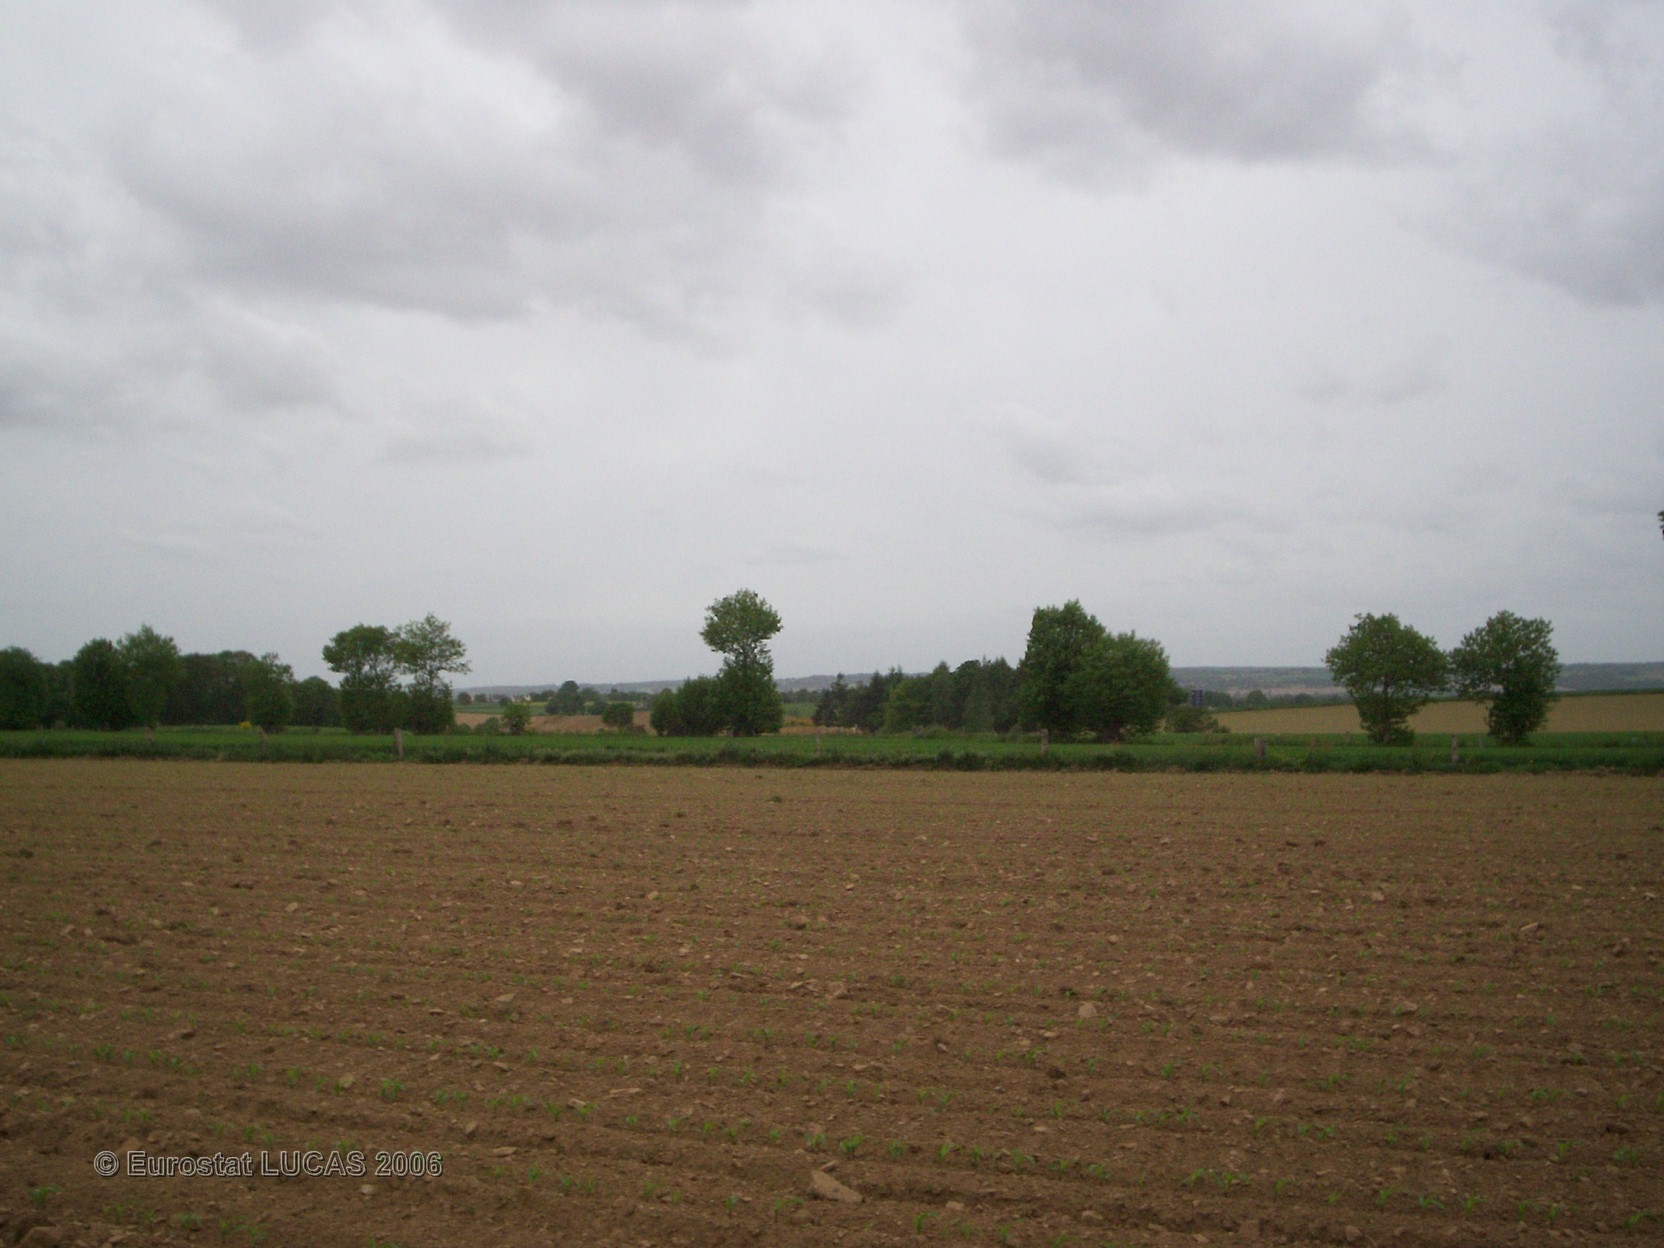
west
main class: Cropland
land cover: Maize
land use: Agriculture (excluding fallow land and kitchen gardens)
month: May
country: FR
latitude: 48.4638
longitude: -1.4196
